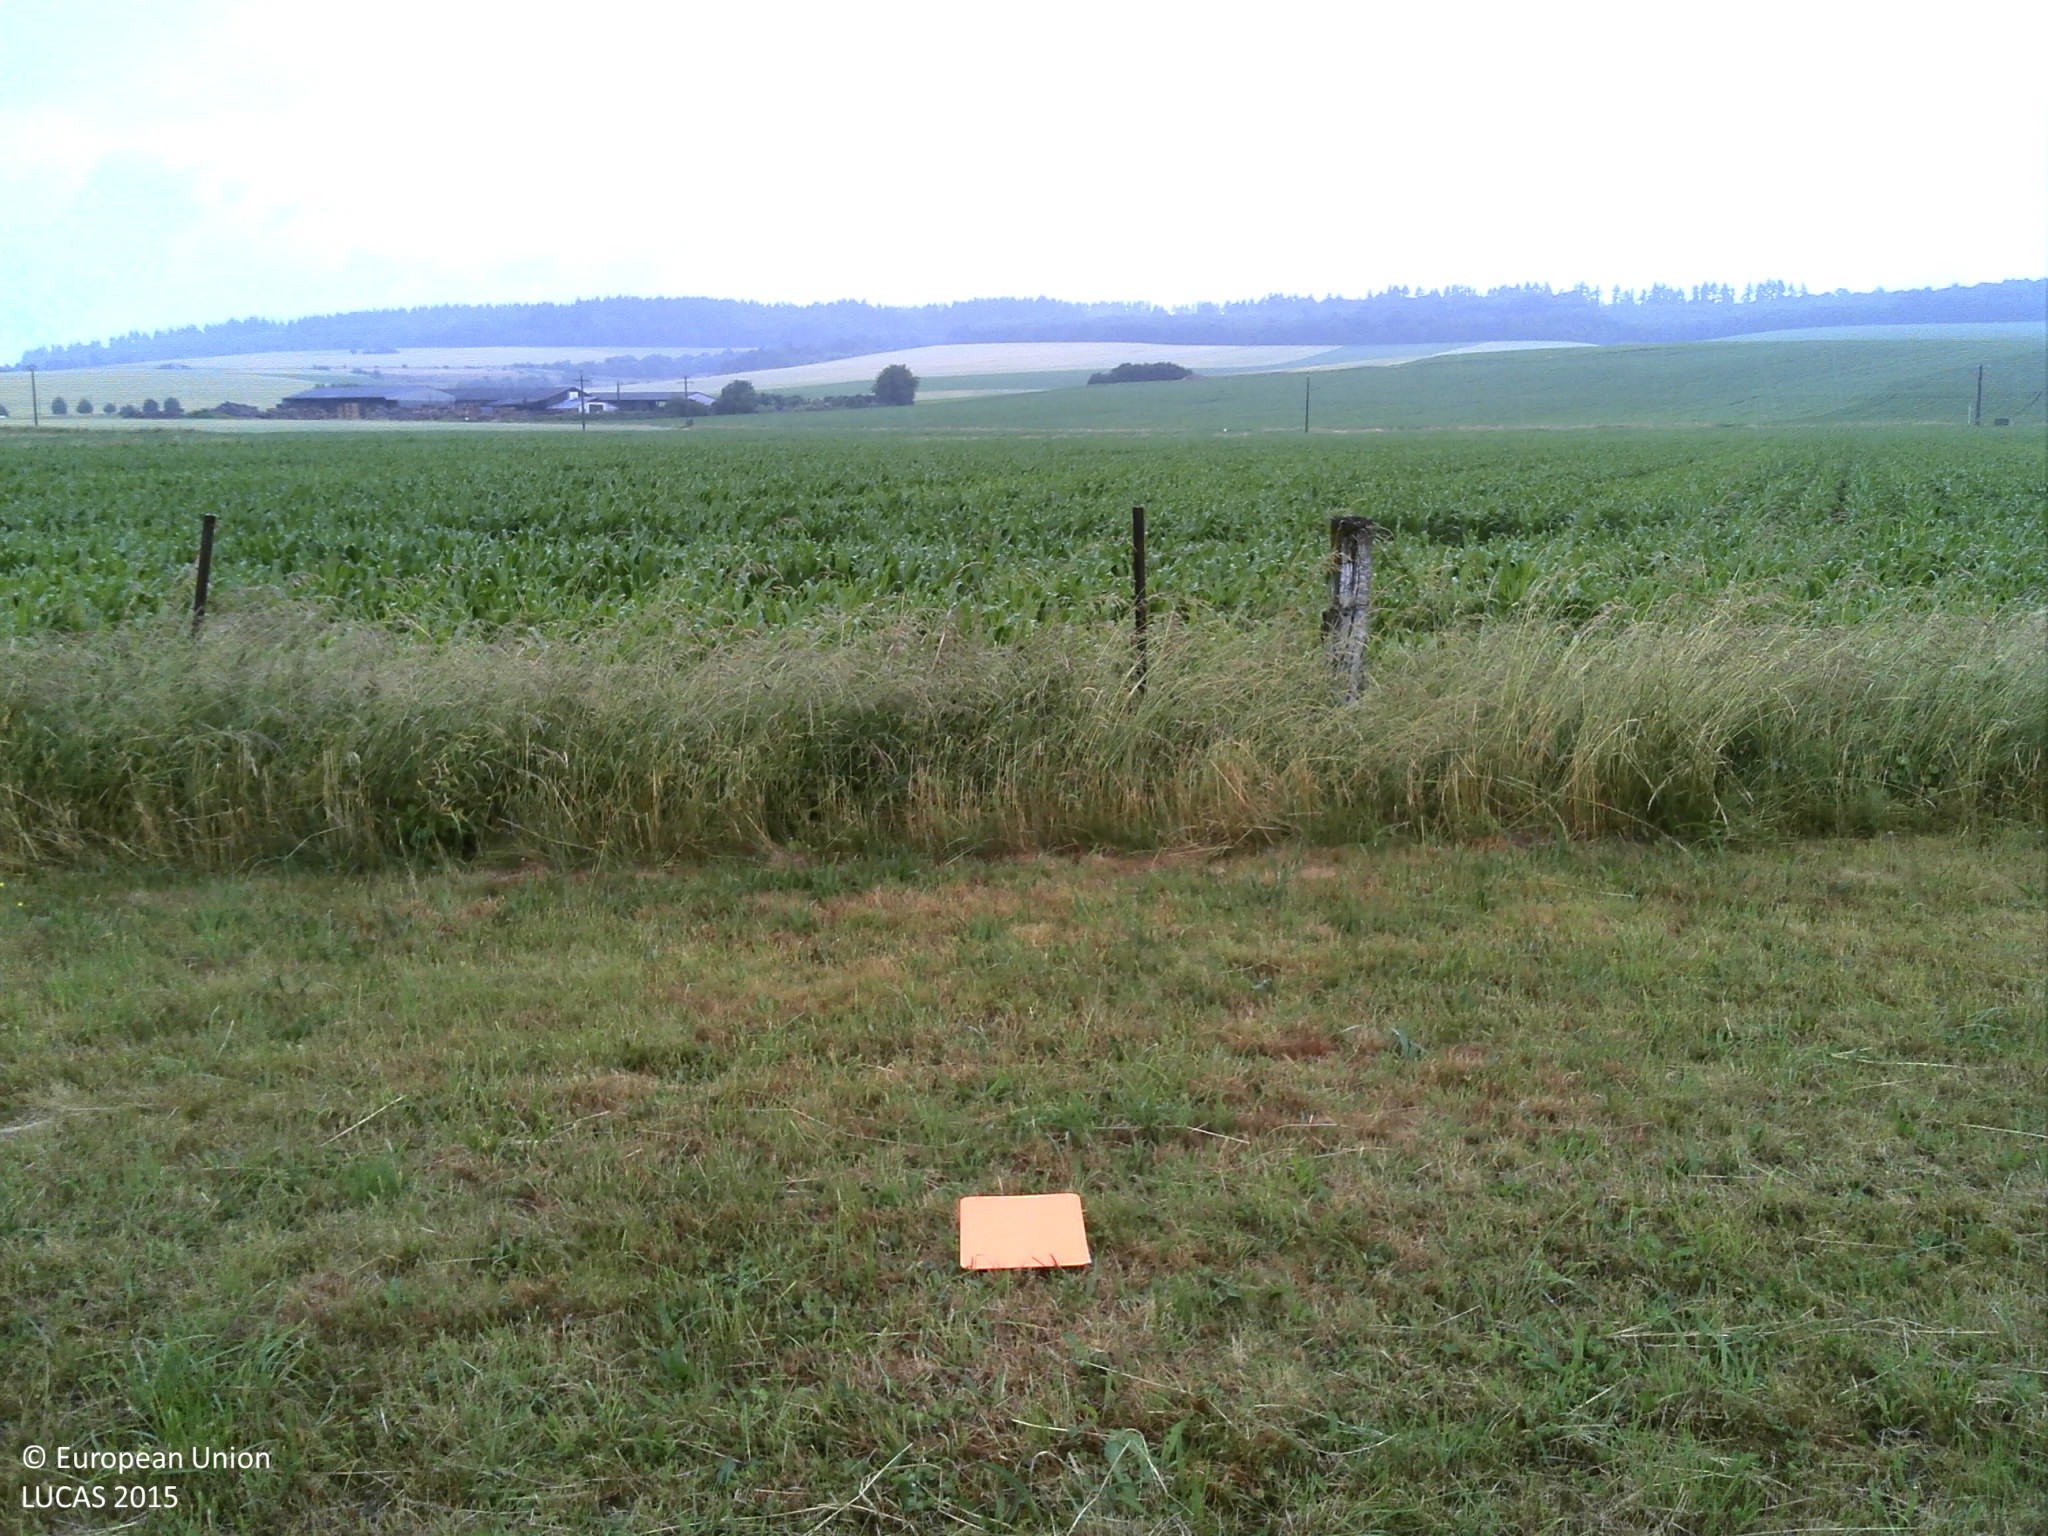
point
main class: Grassland
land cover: Grassland without tree/shrub cover
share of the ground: > 75 %
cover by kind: herbaceous plants 100 %
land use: Amenities, museums, leisure
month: June
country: FR
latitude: 49.5975
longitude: 4.8087
